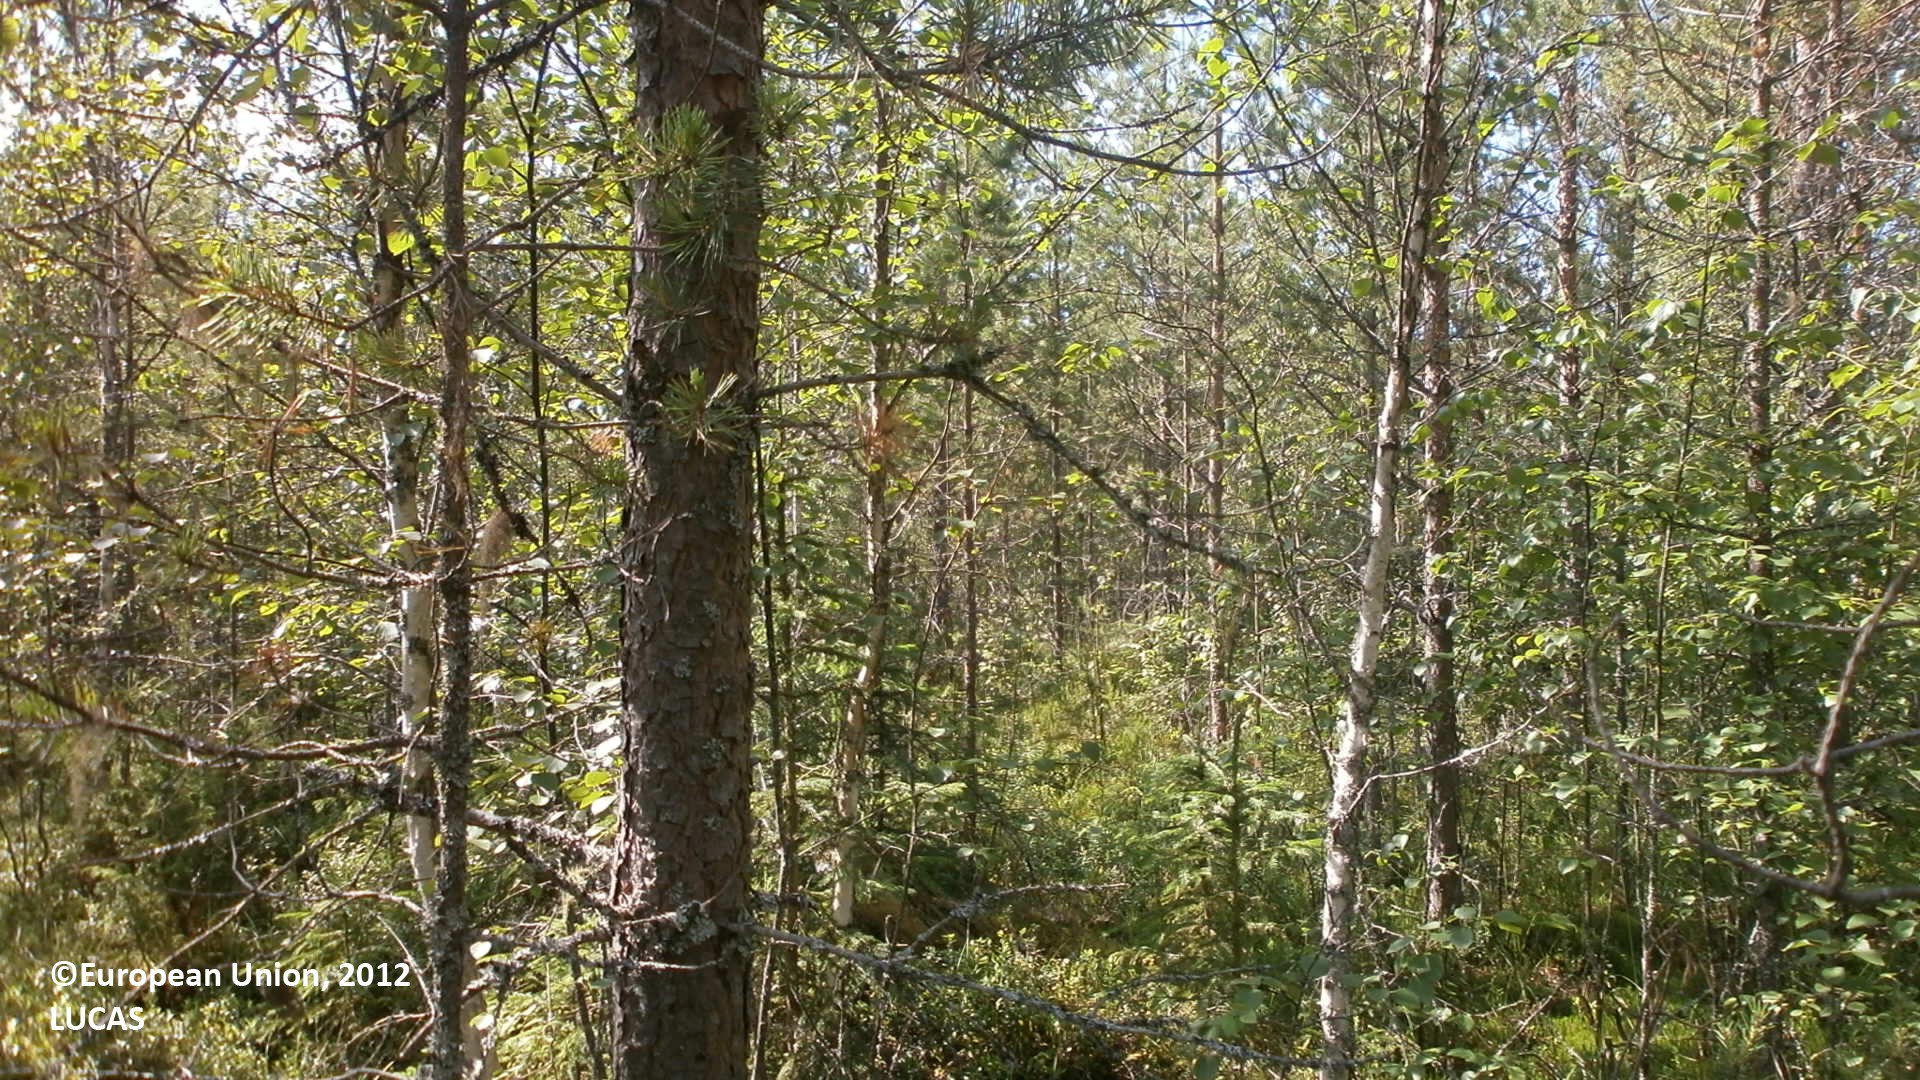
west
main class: Woodland
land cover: Pine dominated mixed woodland
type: boreal forest
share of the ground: 50 - 75 %
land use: Forestry
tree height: > 5 m
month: July
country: FI
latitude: 64.2489
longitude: 24.2395
